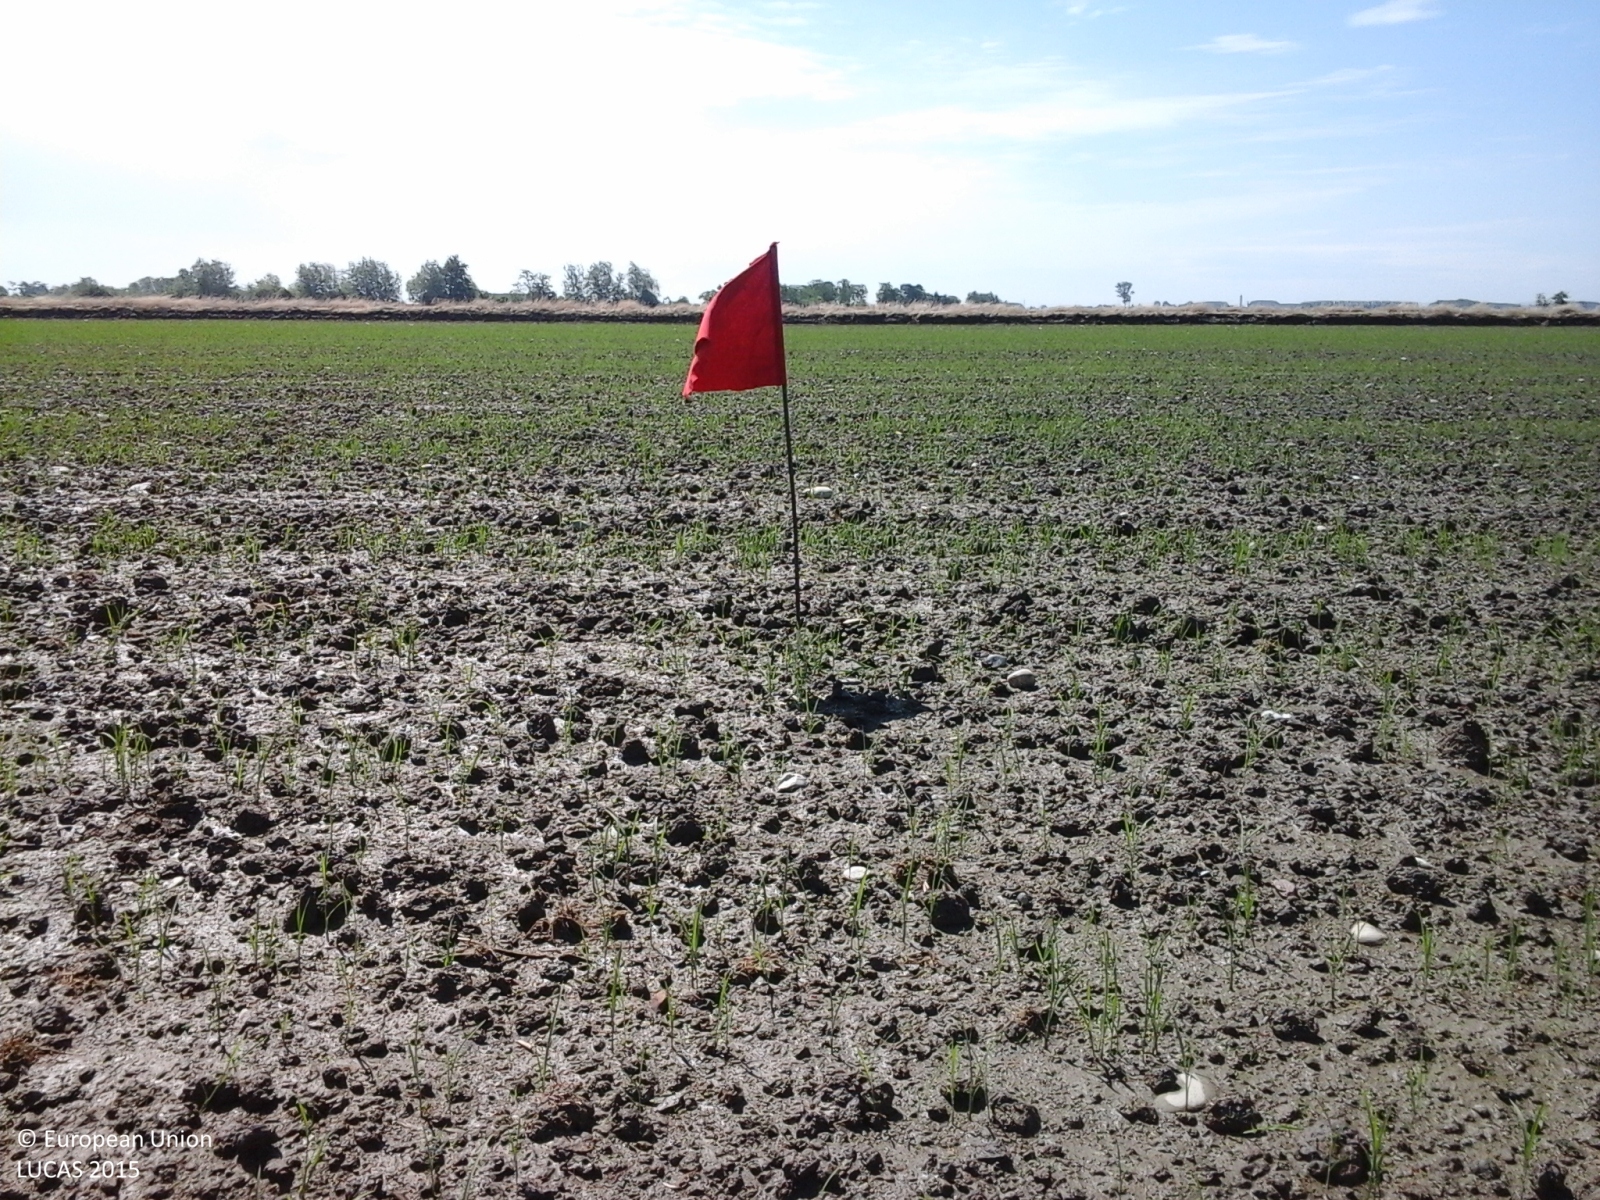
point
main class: Cropland
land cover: Rice
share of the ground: < 10 %
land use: Agriculture (excluding fallow land and kitchen gardens)
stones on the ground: < 10 %
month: May
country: IT
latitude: 45.4207
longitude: 8.4307
